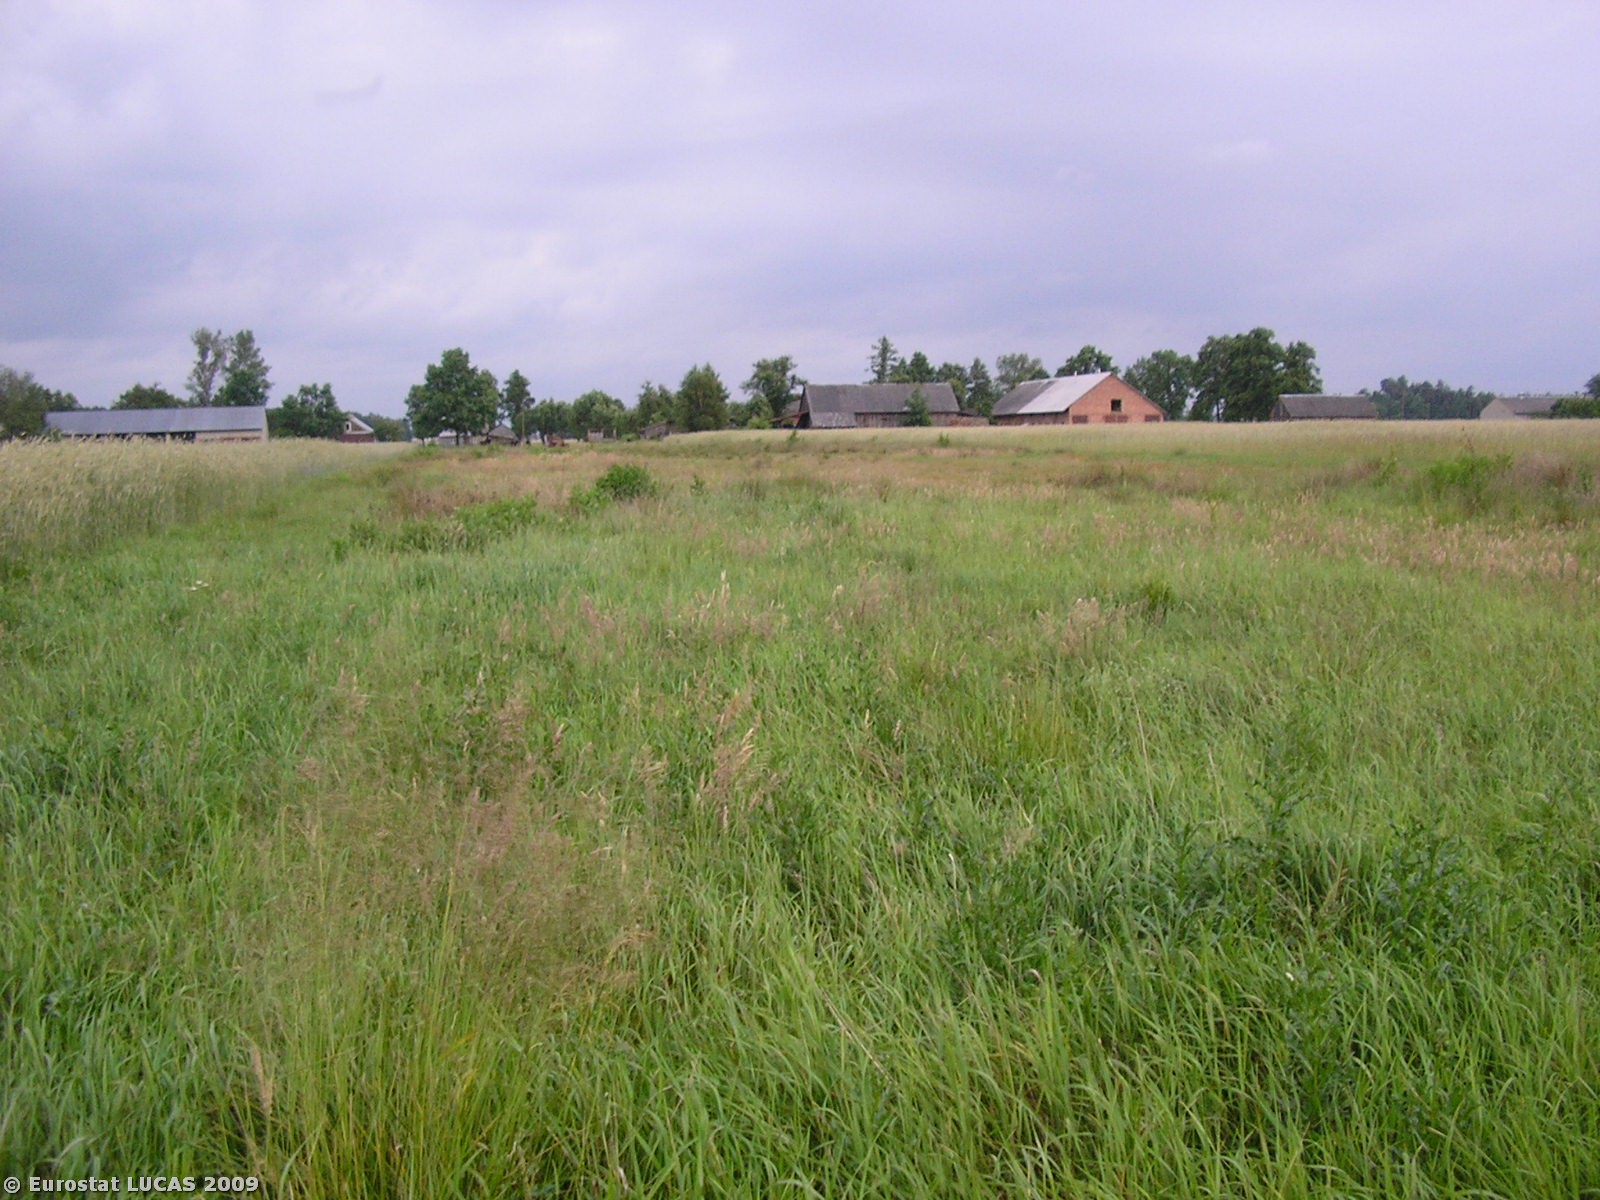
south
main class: Grassland
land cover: Grassland without tree/shrub cover
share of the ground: > 75 %
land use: Agriculture (excluding fallow land and kitchen gardens)
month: June
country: PL
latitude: 51.4304
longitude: 18.3753
